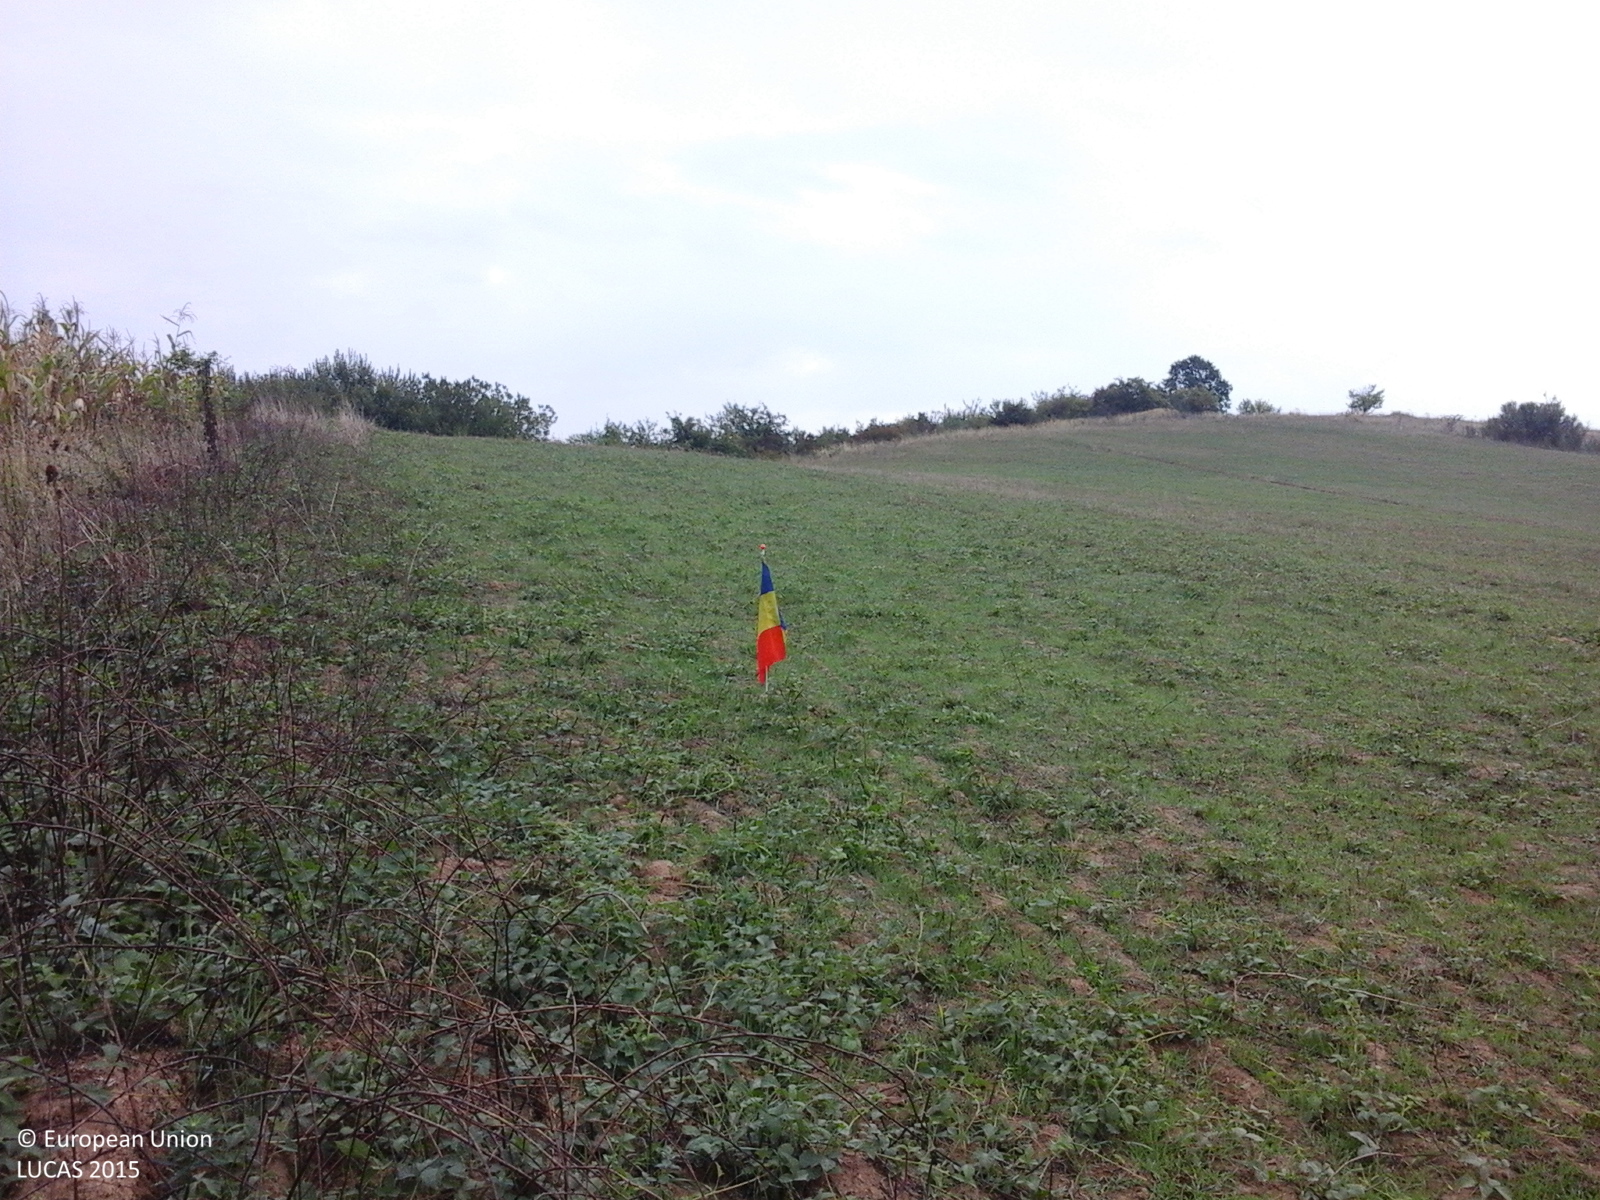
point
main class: Grassland
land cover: Grassland without tree/shrub cover
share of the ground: > 75 %
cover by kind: herbaceous plants 100 %
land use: Agriculture (excluding fallow land and kitchen gardens)
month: September
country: RO
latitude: 45.4729
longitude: 21.9984
